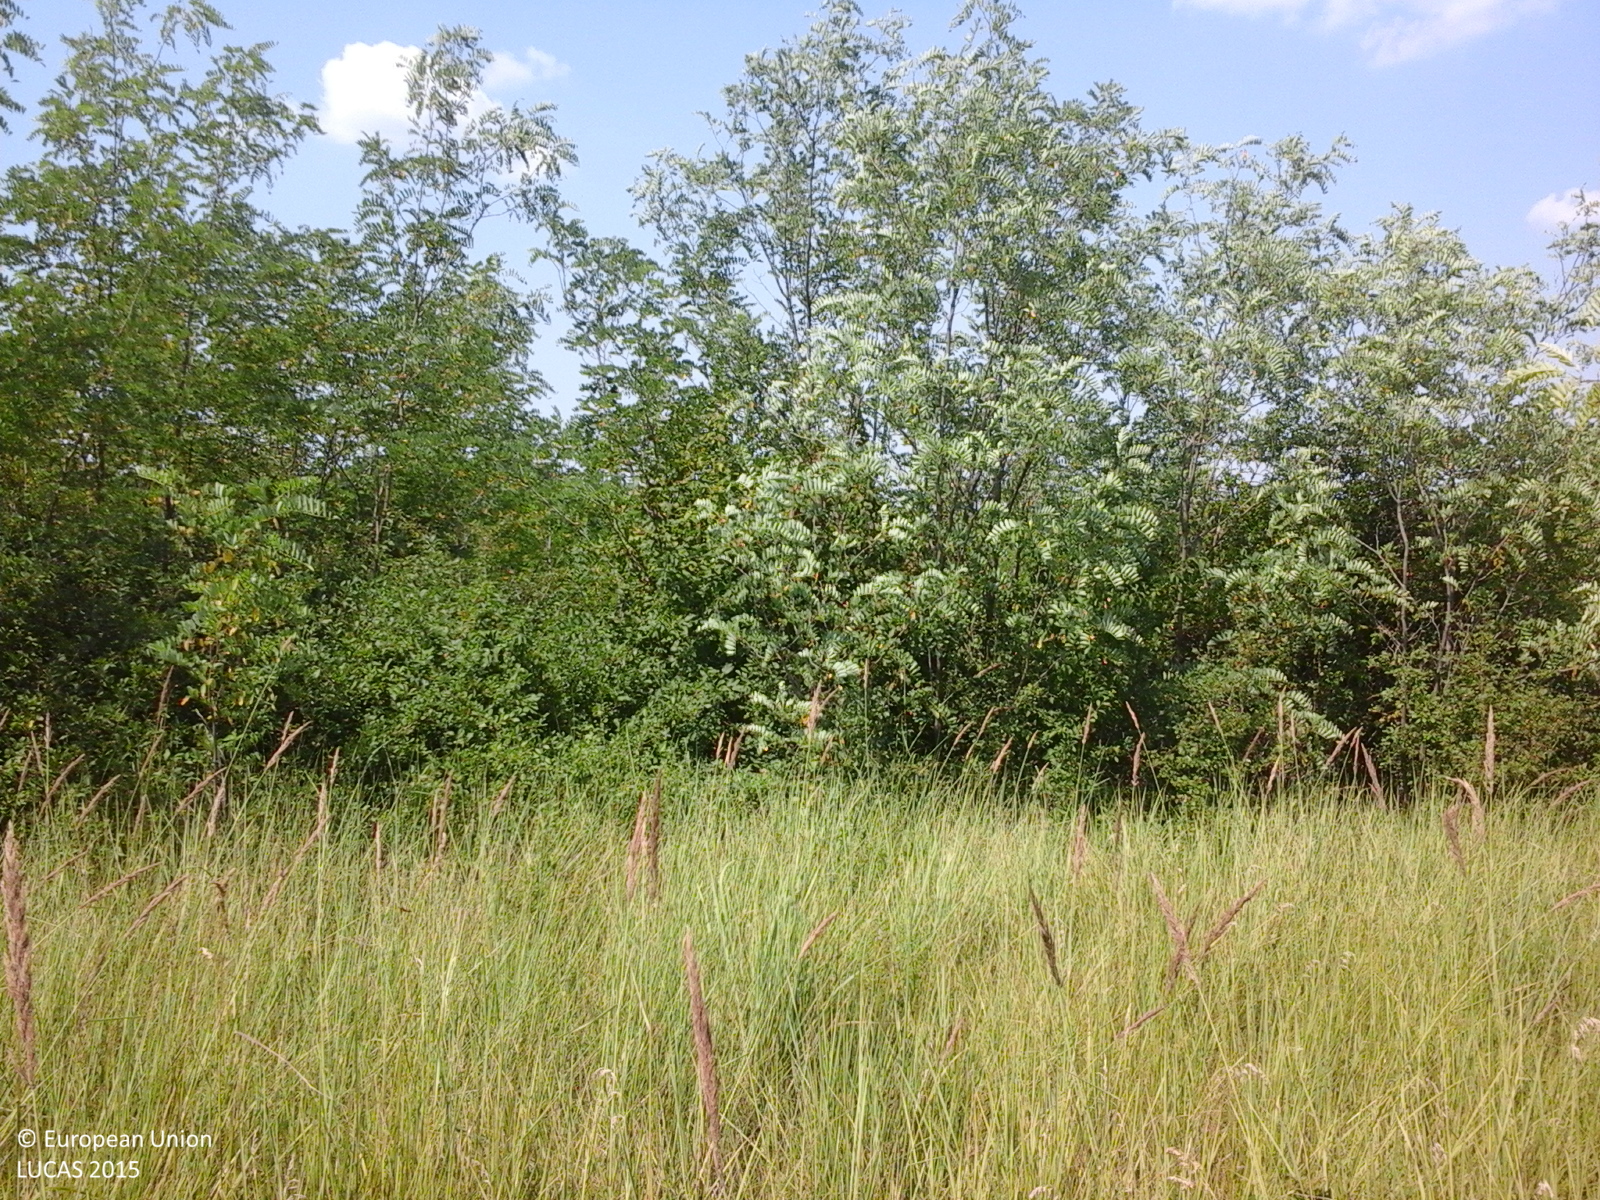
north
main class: Grassland
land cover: Spontaneously vegetated surfaces
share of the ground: > 75 %
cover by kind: herbaceous plants 100 %
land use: Fallow land
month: July
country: RO
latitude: 44.7375
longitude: 24.6106
